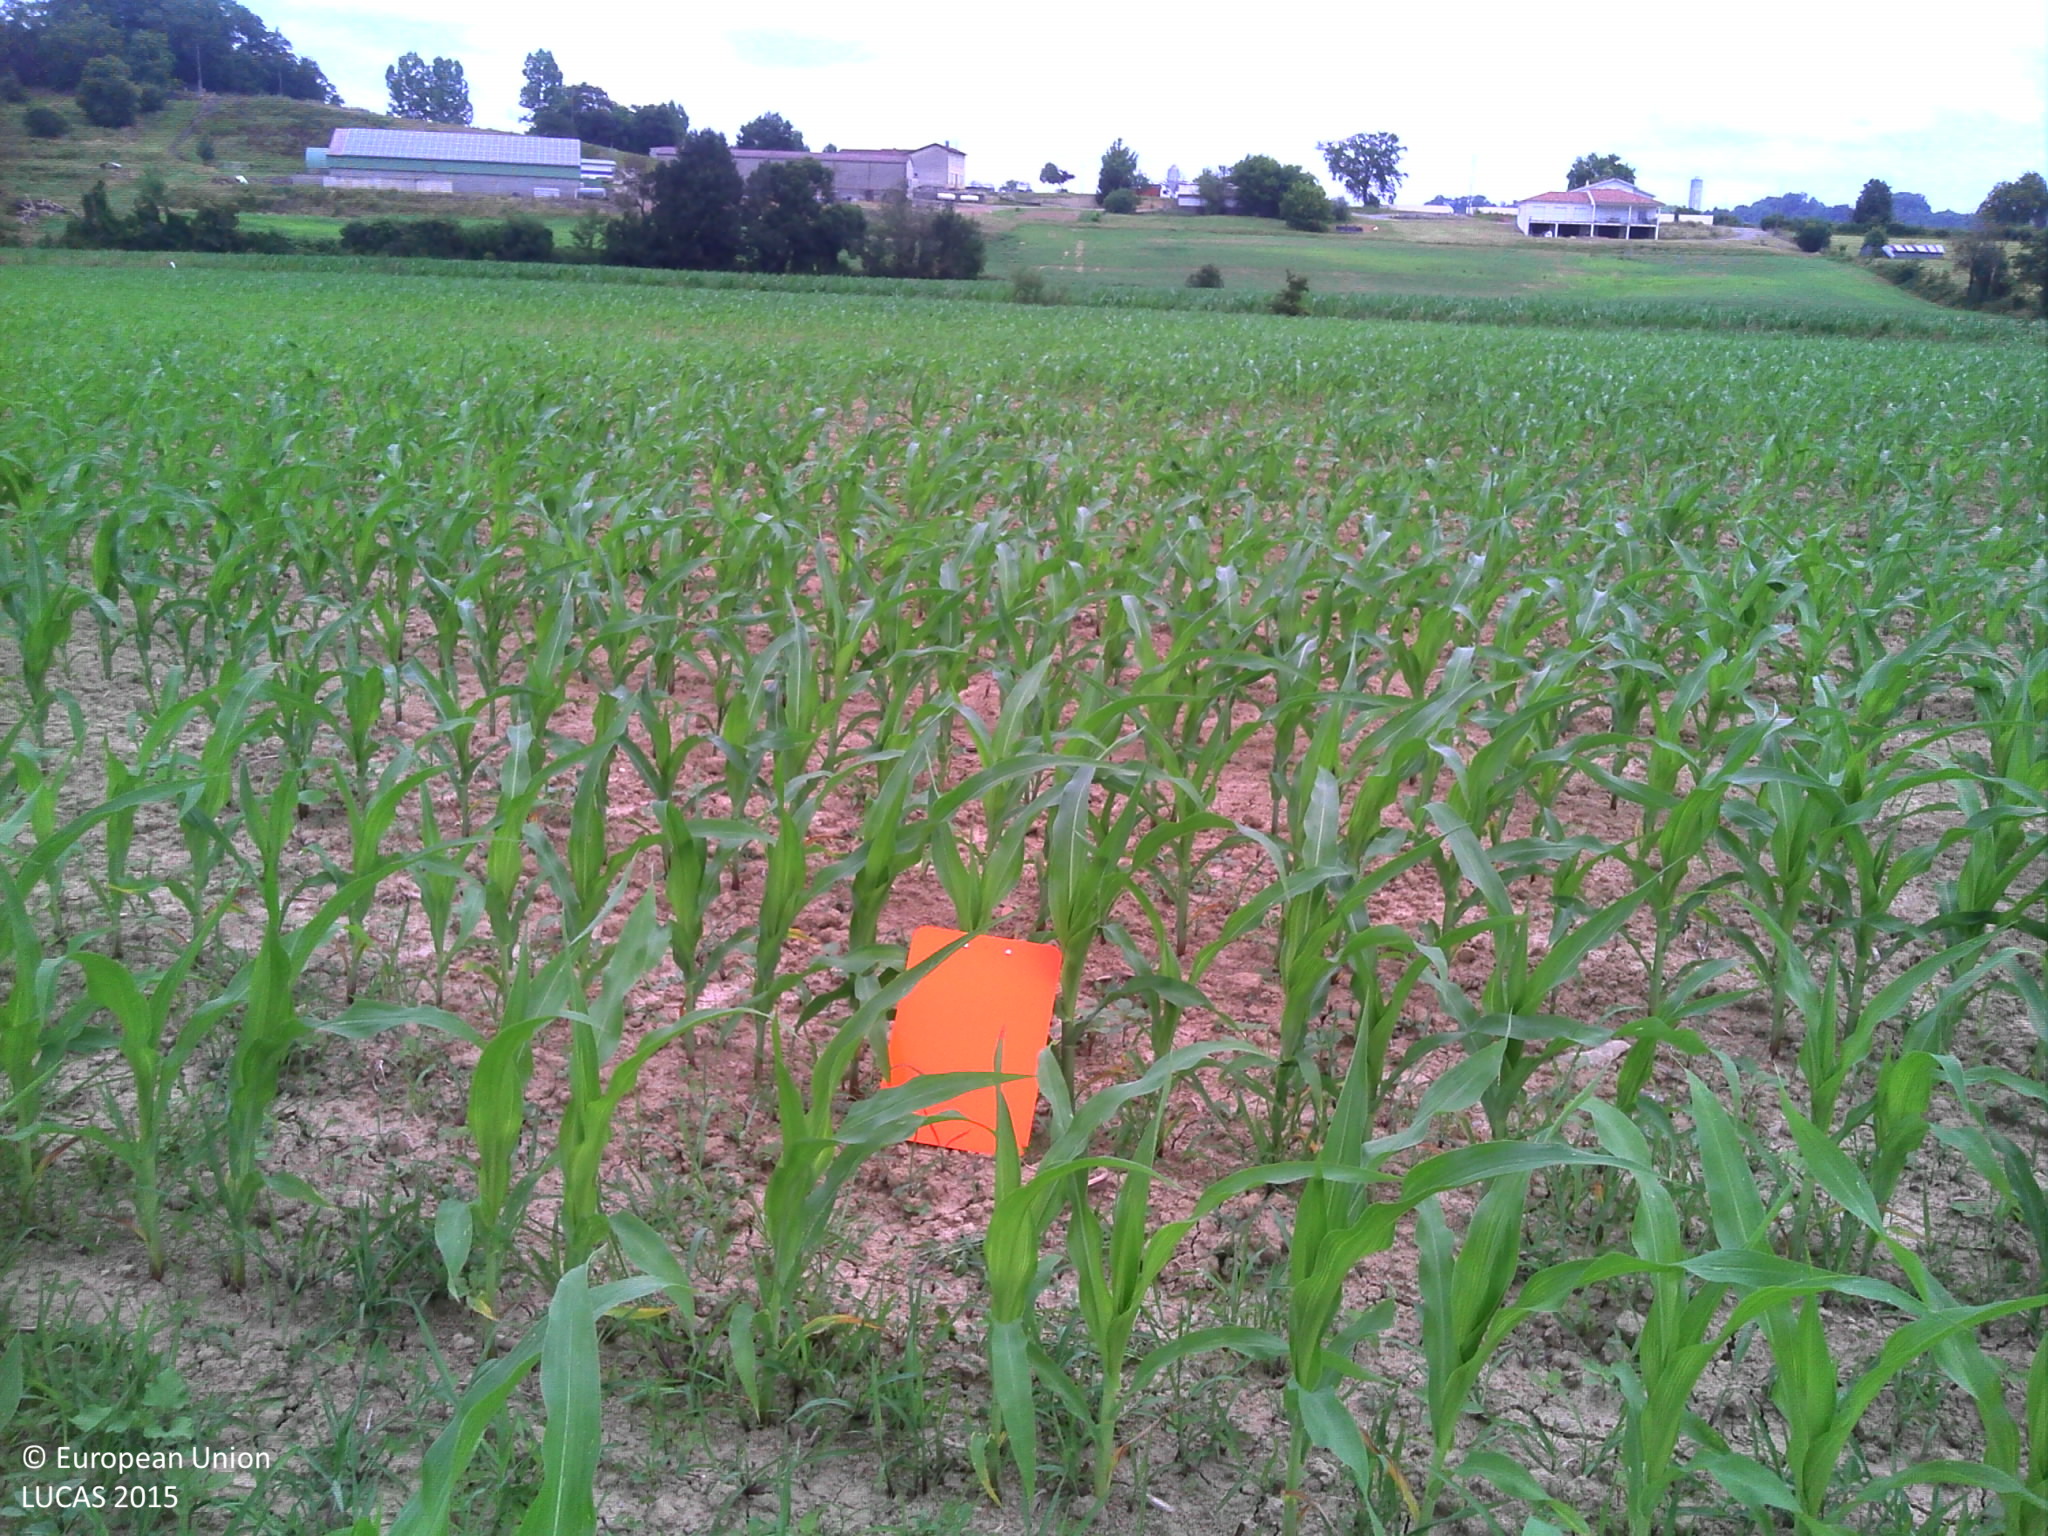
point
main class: Cropland
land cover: Maize
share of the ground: 50 - 75 %
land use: Agriculture (excluding fallow land and kitchen gardens)
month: July
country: FR
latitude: 43.6235
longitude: -0.7818
